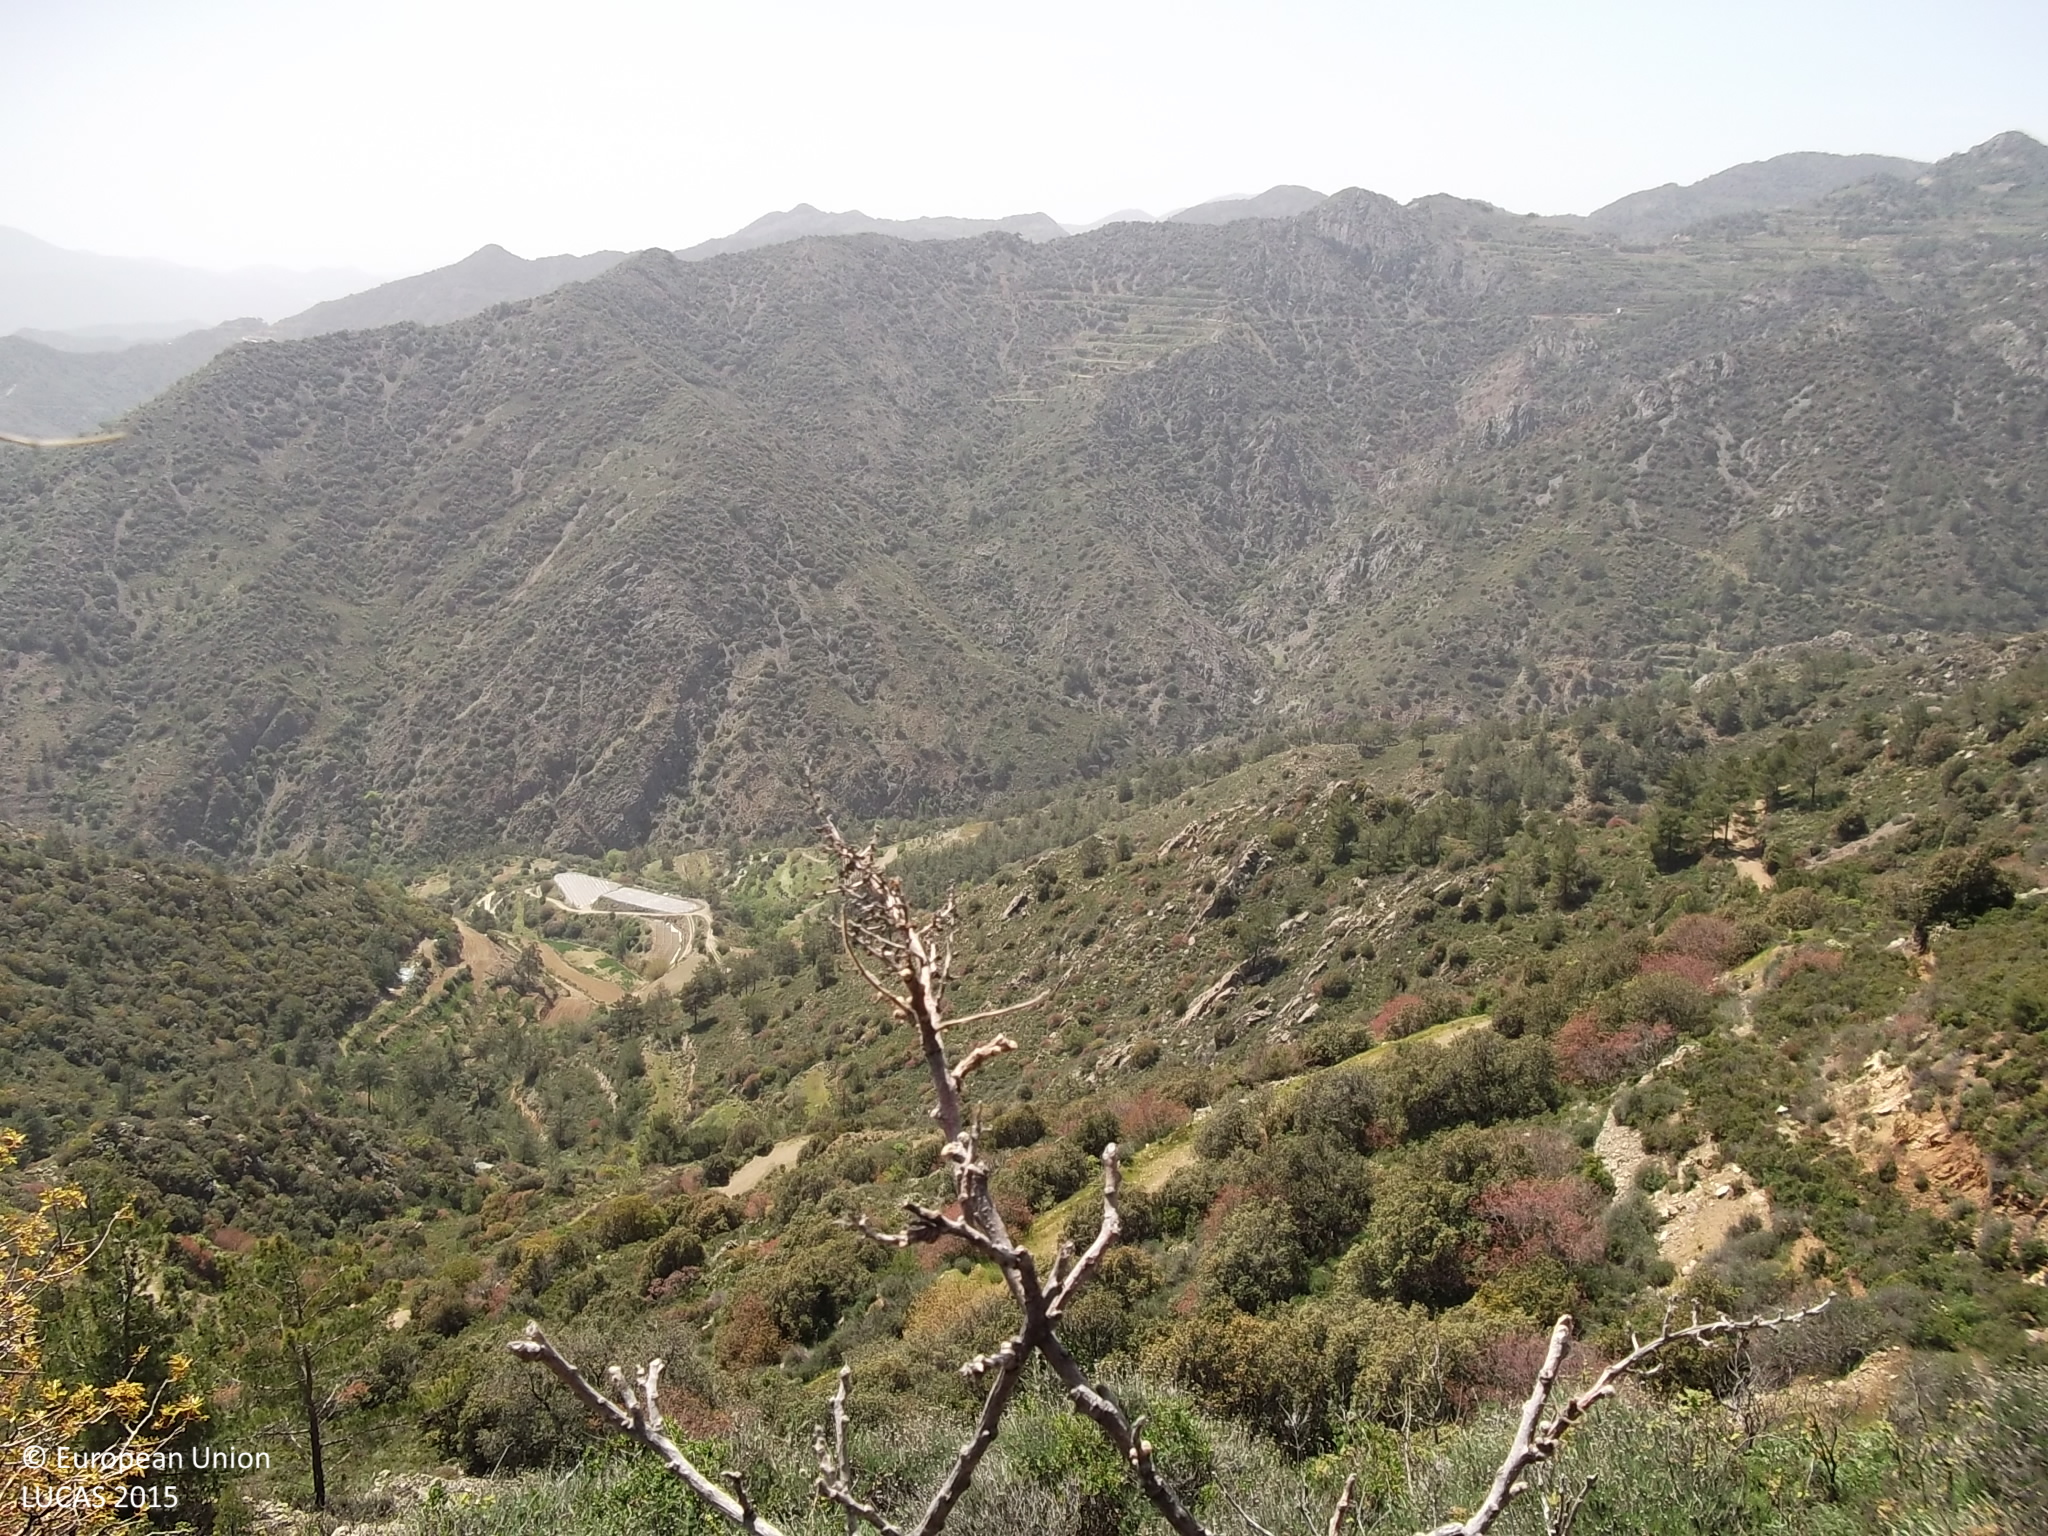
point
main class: Shrubland
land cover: Shrubland without tree cover
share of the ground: > 75 %
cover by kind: shrubs 75 %, consolidated bare surface 15 %, unconsolidated bare surface 10 %
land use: Semi-natural and natural areas not in use
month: April
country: CY
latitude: 34.8951
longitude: 33.1906
